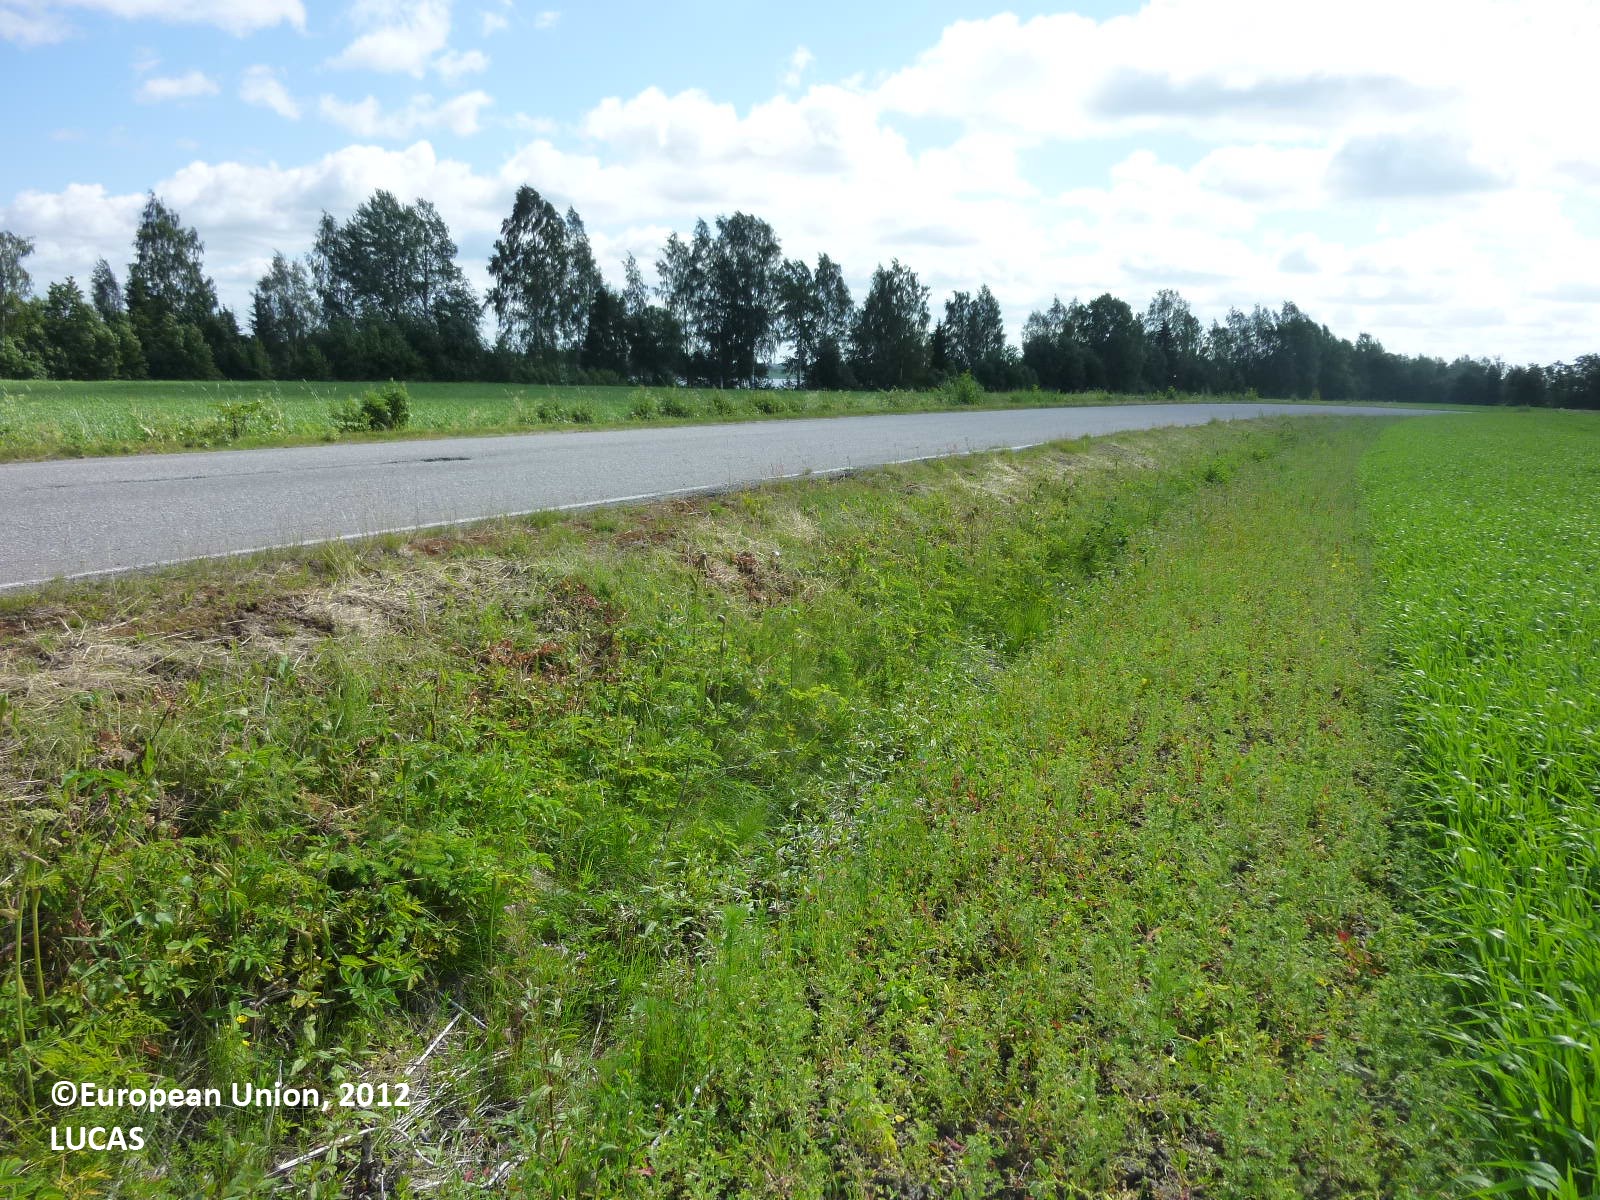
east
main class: Cropland
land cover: Barley
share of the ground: > 75 %
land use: Agriculture (excluding fallow land and kitchen gardens)
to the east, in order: Barley; Grass margins; Ditches and canals; Grass margins; Paved roads, cycling and walking lanes; Grass margins; Abandoned hedges; Ditches and canals; Grass margins; Barley; Other bare soil; Broadleaved woodland; Inland running water
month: July
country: FI
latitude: 61.2910
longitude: 22.2096
